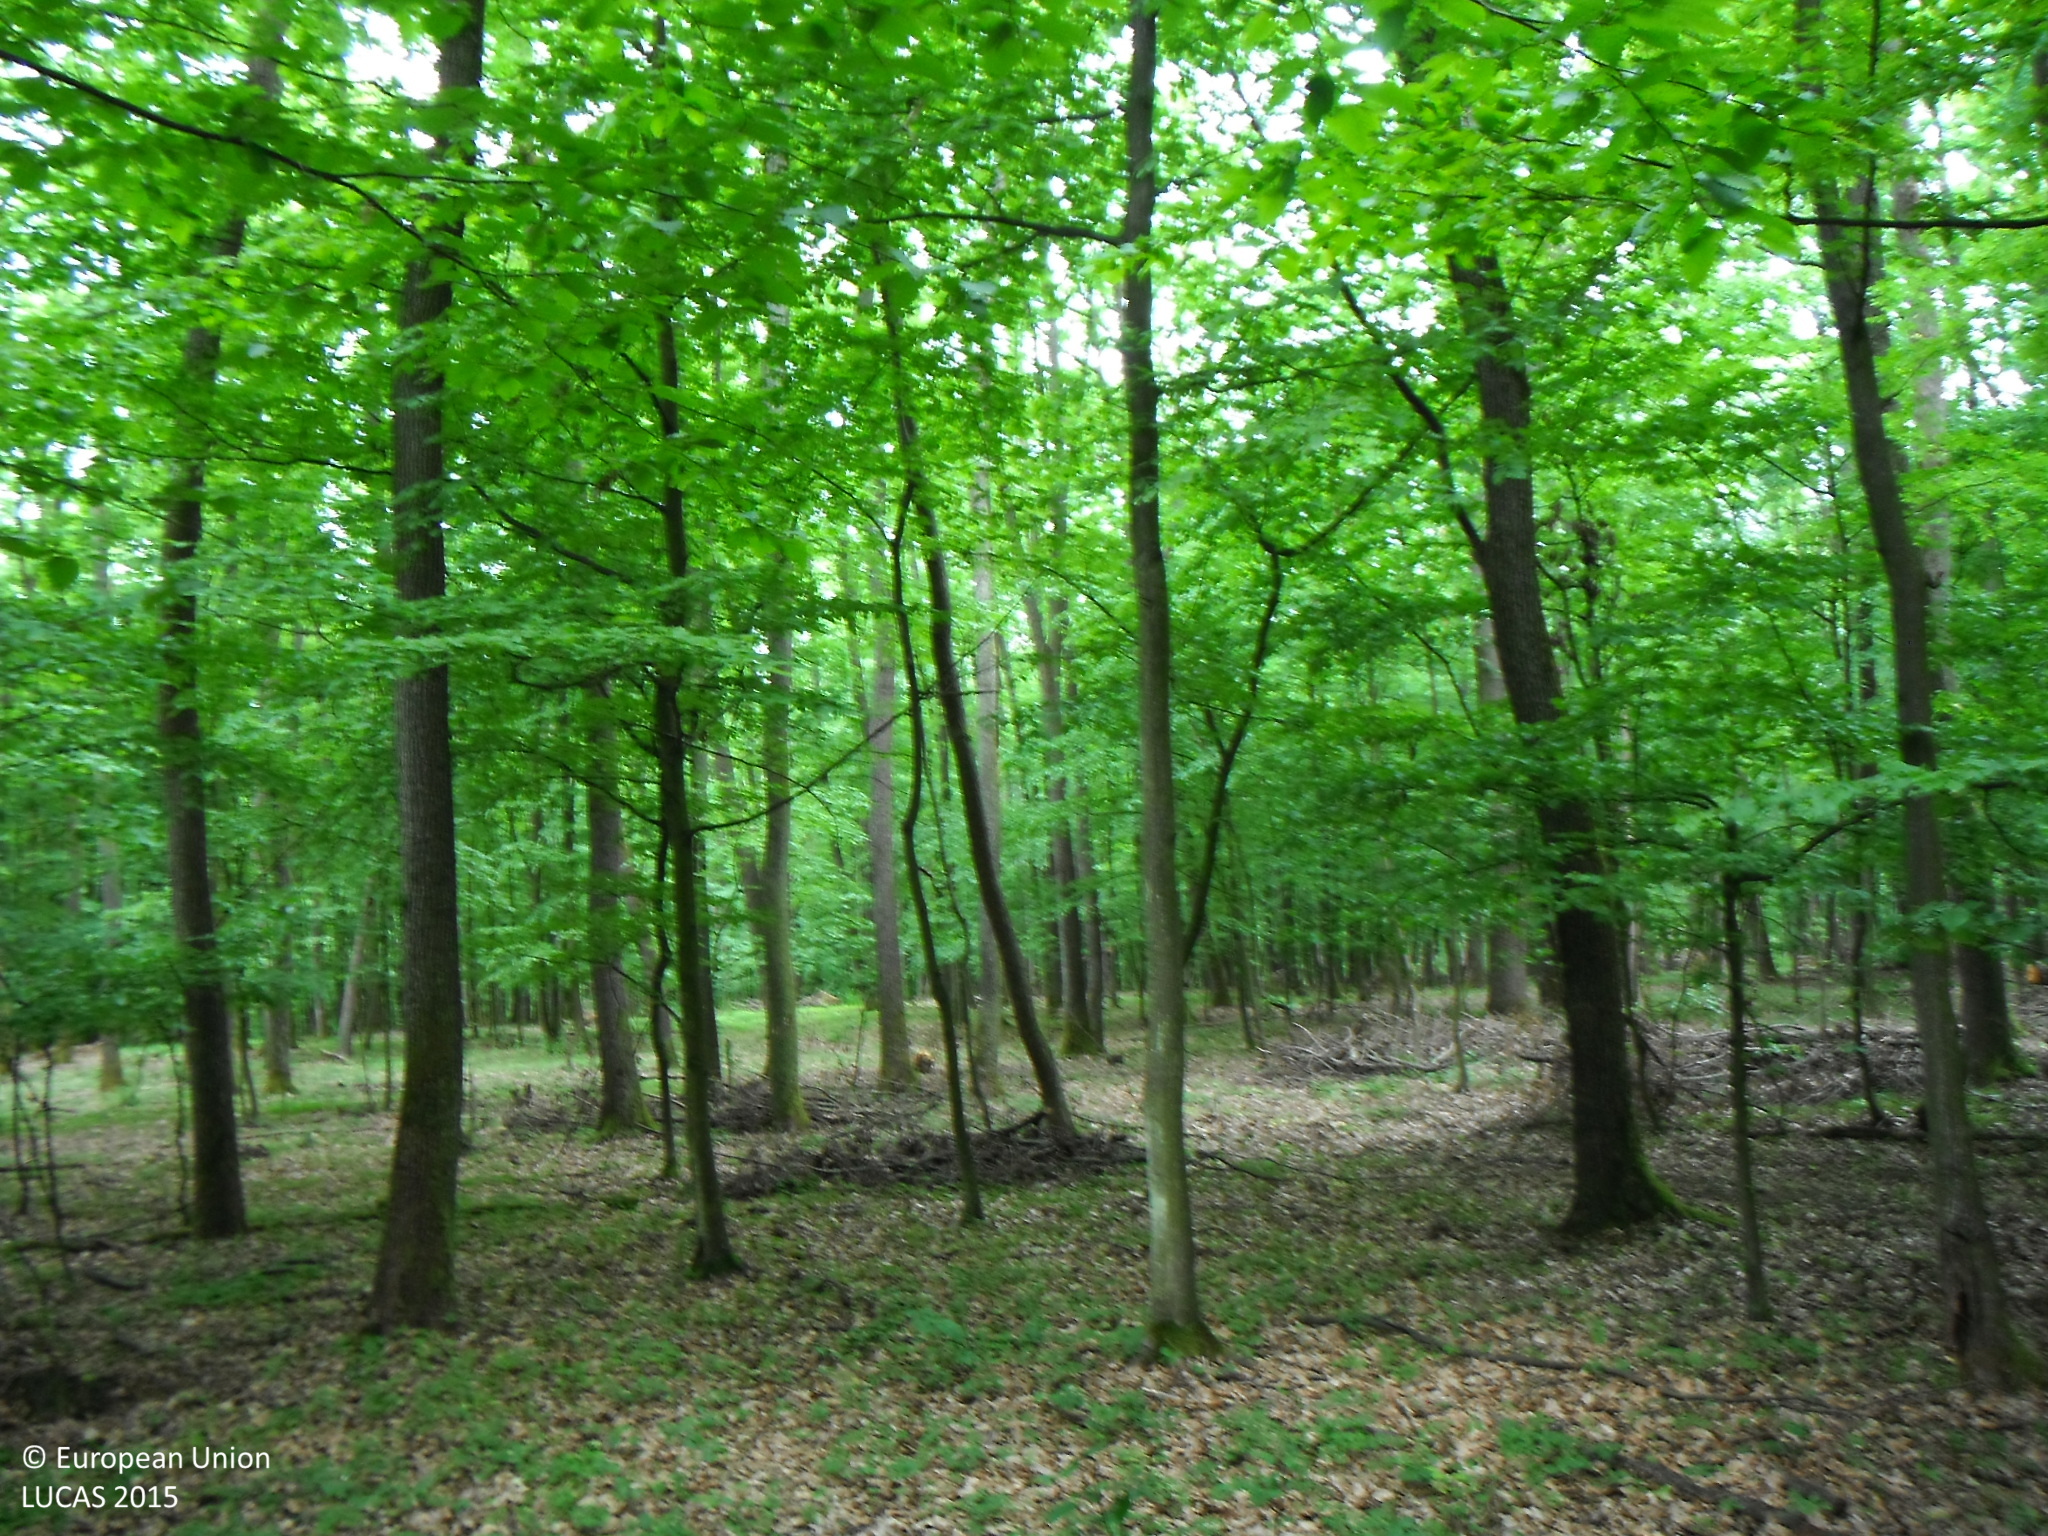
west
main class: Woodland
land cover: Broadleaved woodland
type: acidophilous oak and oak-birch forest
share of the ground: > 75 %
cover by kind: broadleaved forest trees 95 %, coniferous forest trees 5 %
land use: Forestry
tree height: > 5 m
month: May
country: SK
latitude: 48.6469
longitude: 21.0494
